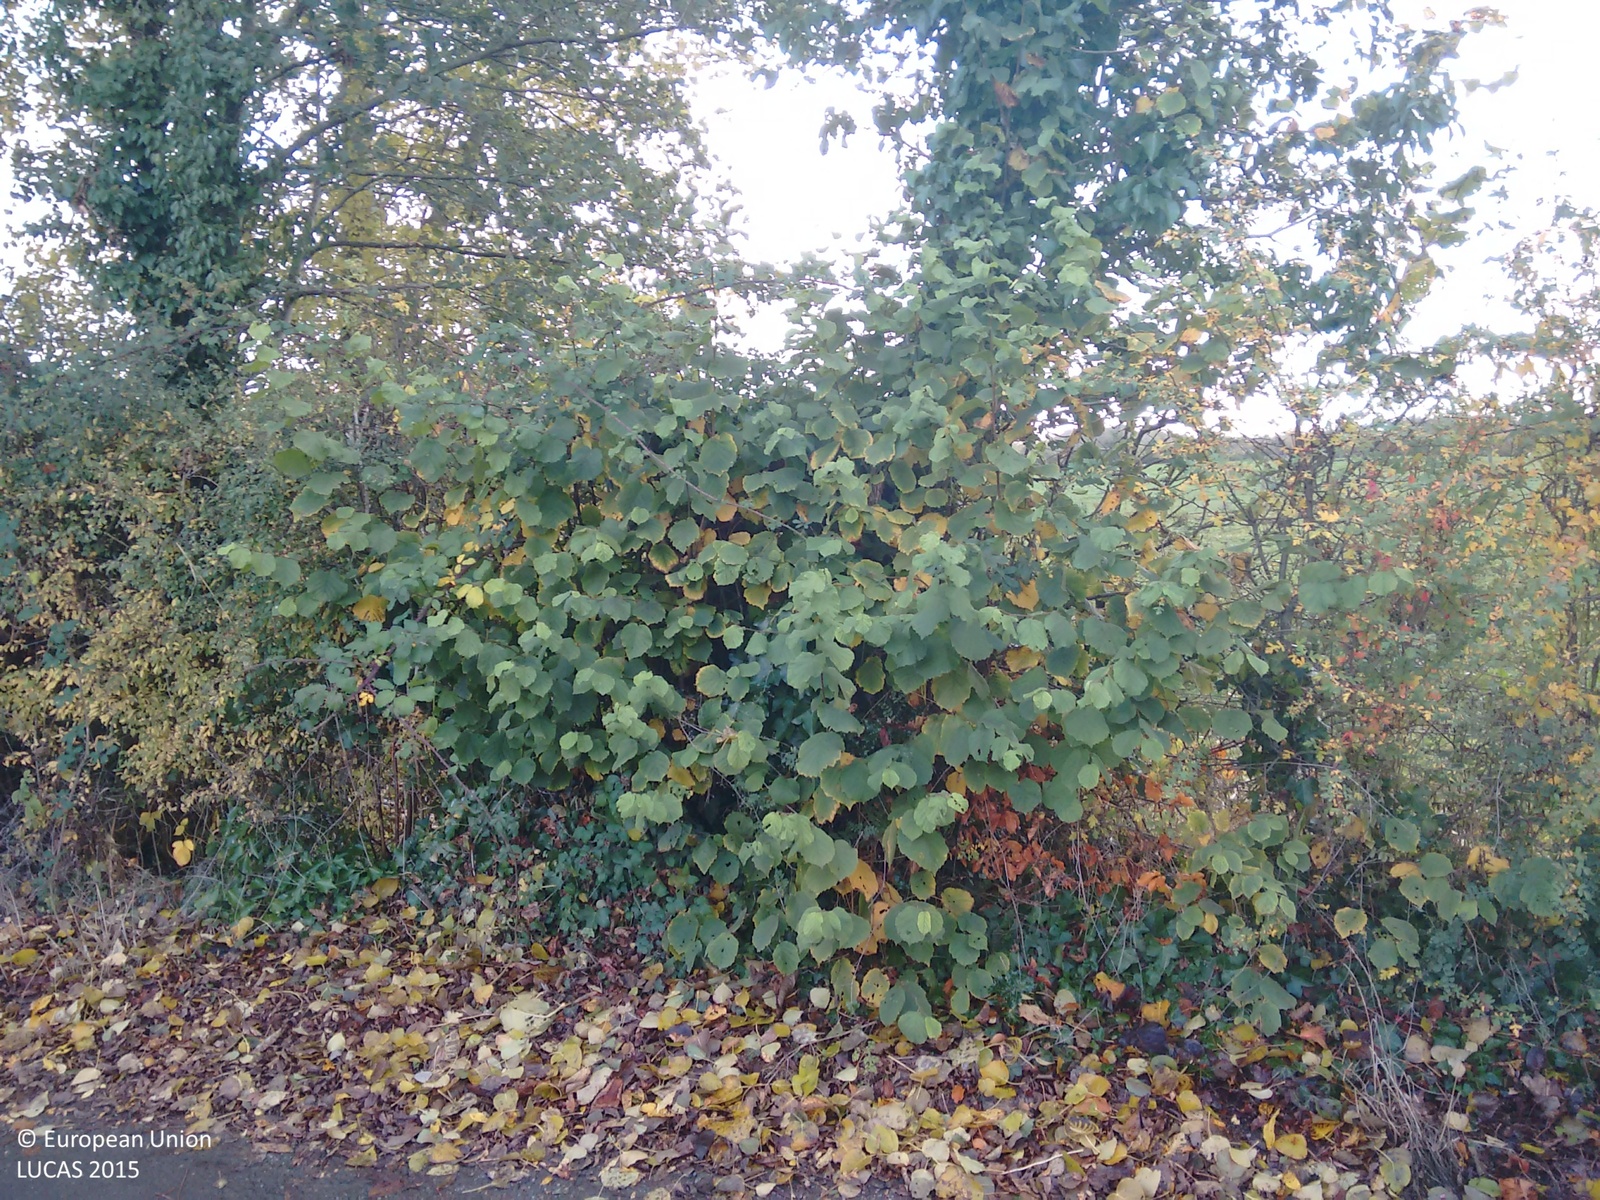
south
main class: Grassland
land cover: Grassland without tree/shrub cover
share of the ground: > 75 %
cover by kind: herbaceous plants 70 %, shrubs 5 %, consolidated bare surface 5 %
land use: Agriculture (excluding fallow land and kitchen gardens)
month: October
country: IE
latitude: 53.1814
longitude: -7.7488
